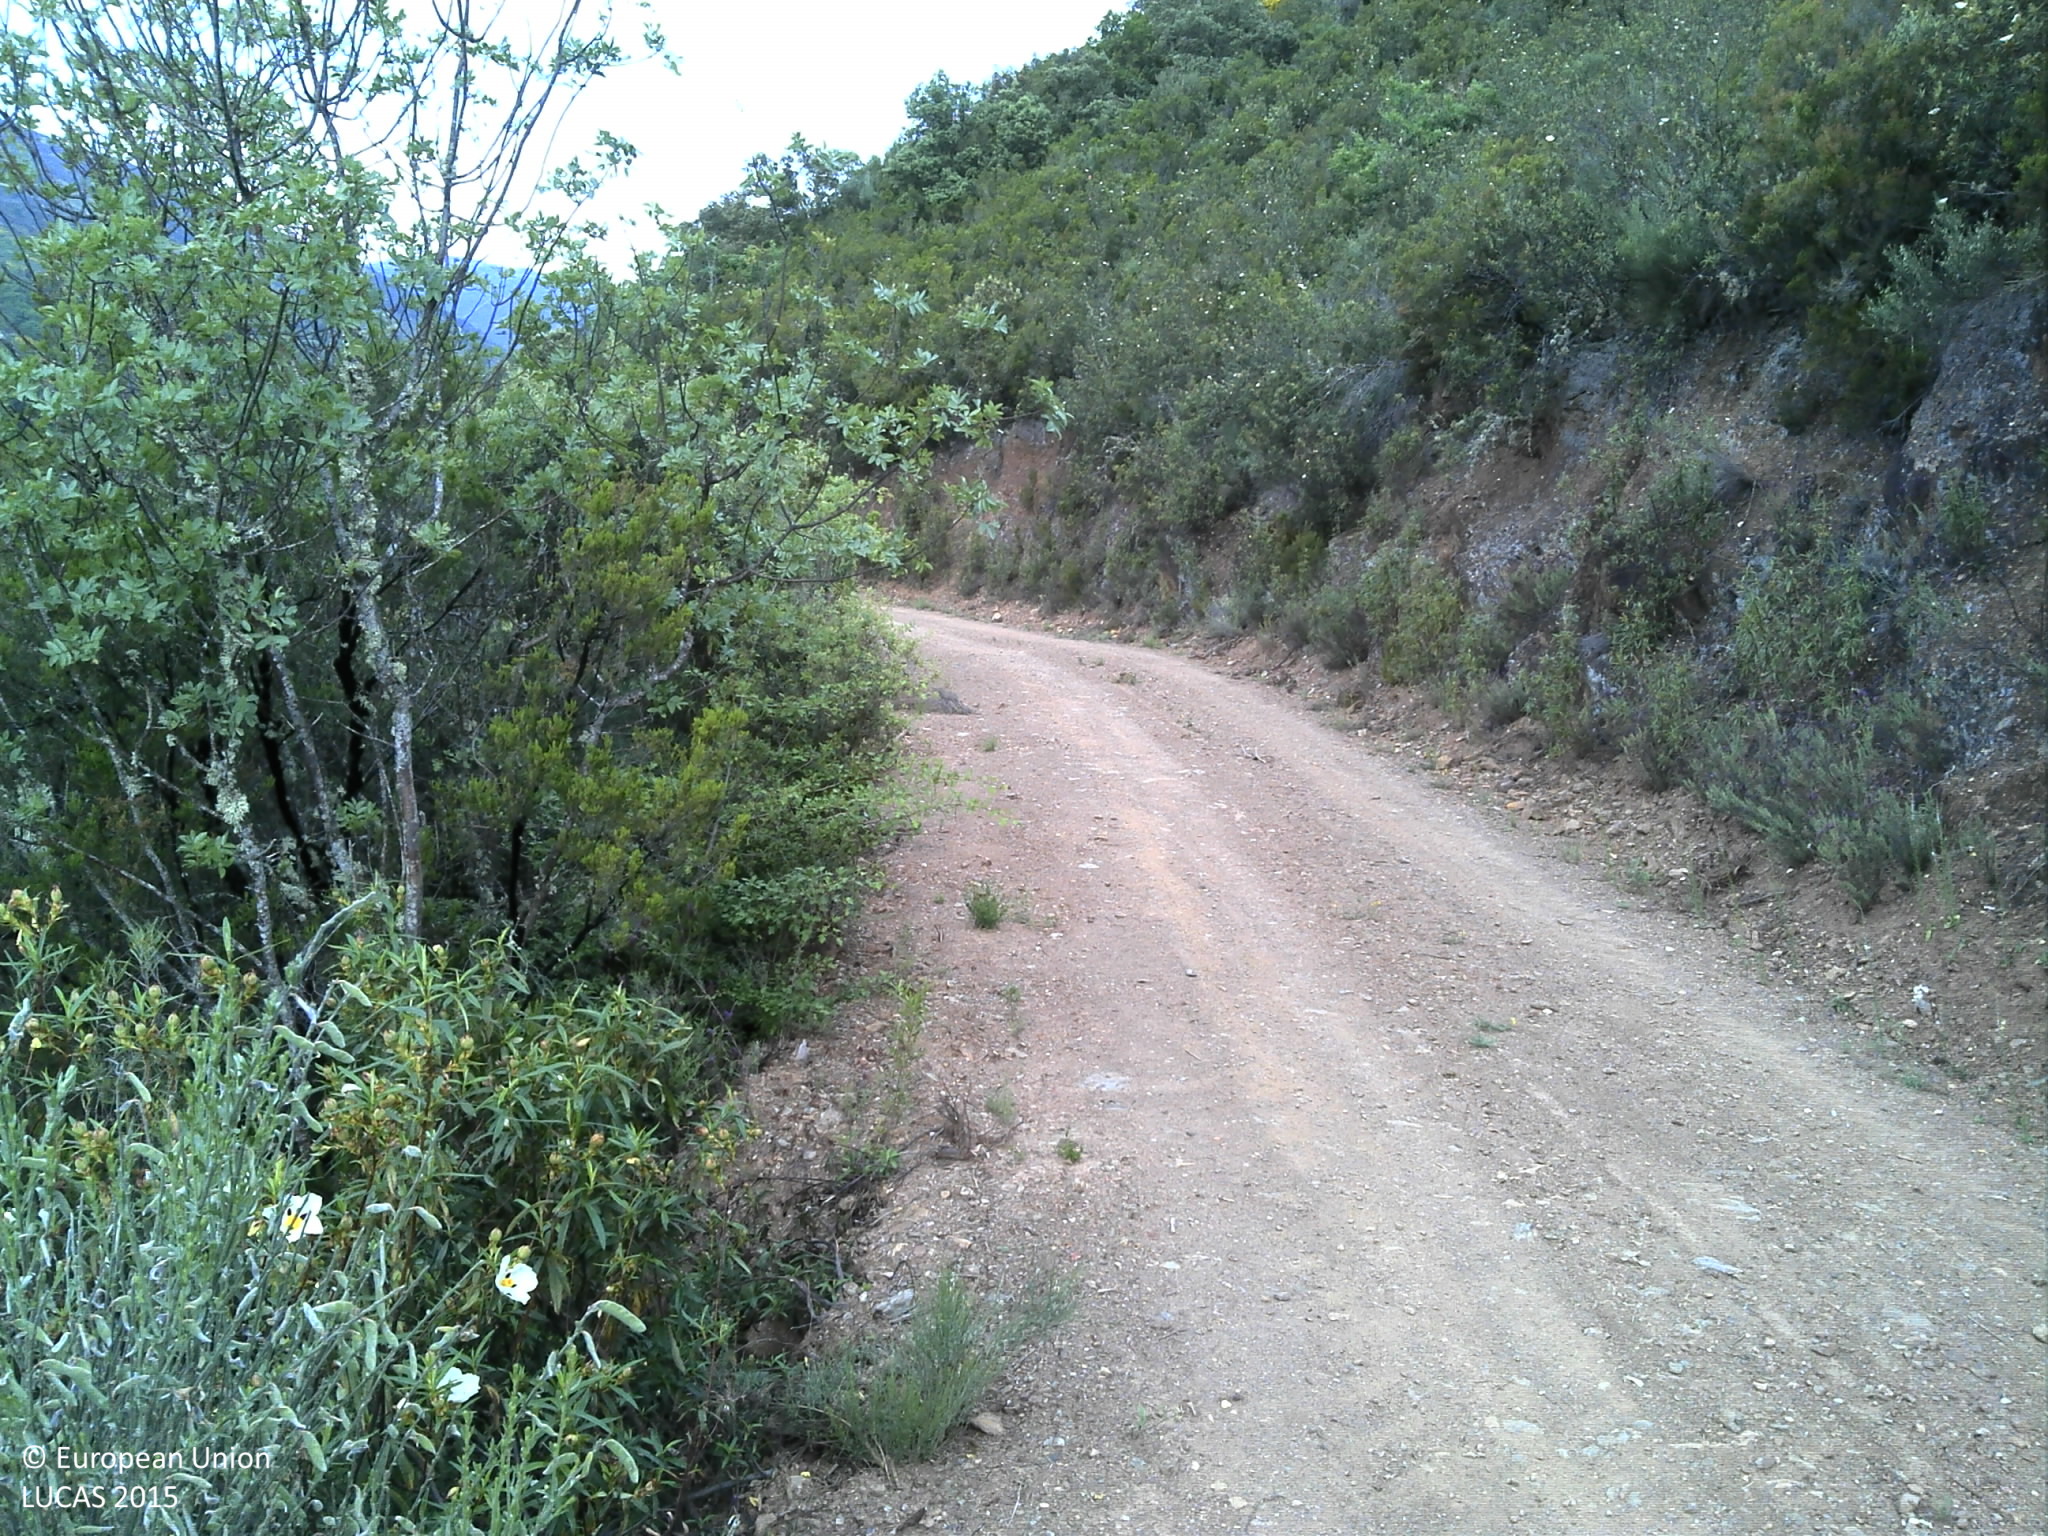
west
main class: Shrubland
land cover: Shrubland without tree cover
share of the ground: > 75 %
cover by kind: shrubs 90 %, unconsolidated bare surface 10 %
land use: Abandoned areas
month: May
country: PT
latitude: 41.7934
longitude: -7.0026
